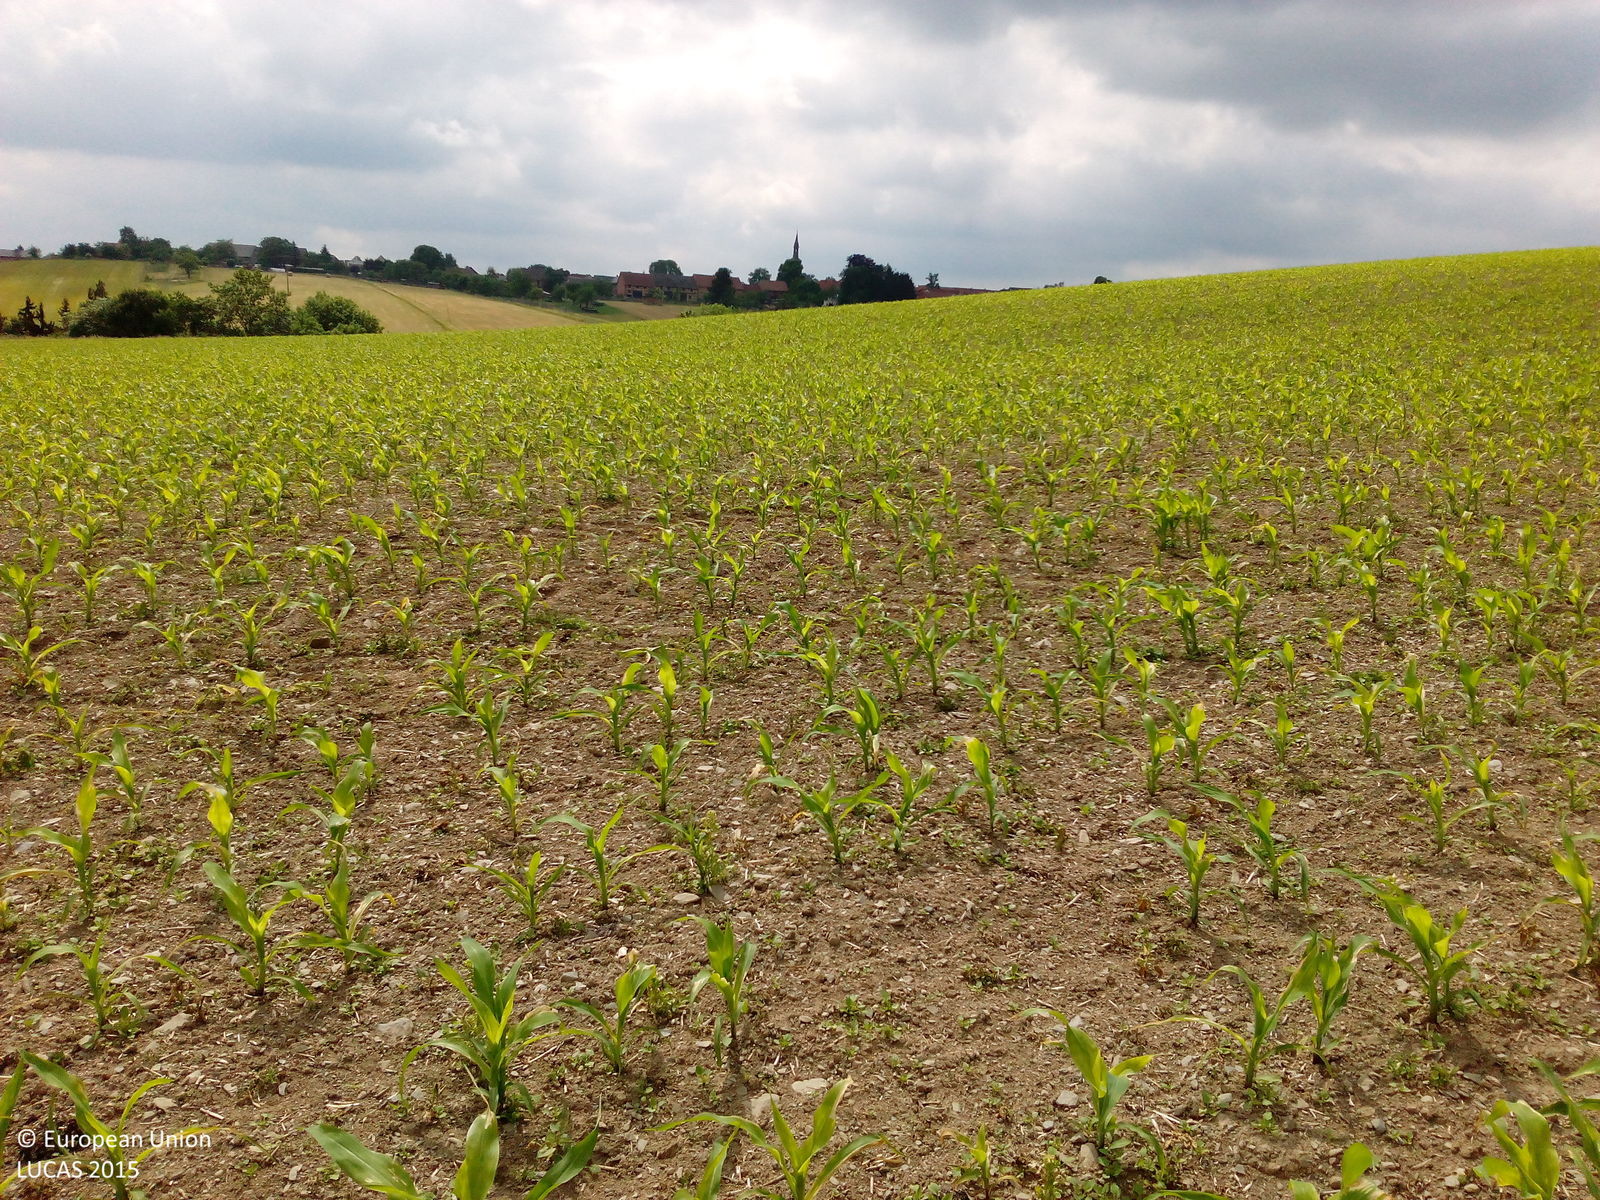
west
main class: Cropland
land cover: Maize
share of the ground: 10 - 25 %
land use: Agriculture (excluding fallow land and kitchen gardens)
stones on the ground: 10 - 25 %
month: June
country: DE
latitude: 50.6227
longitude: 11.5969
